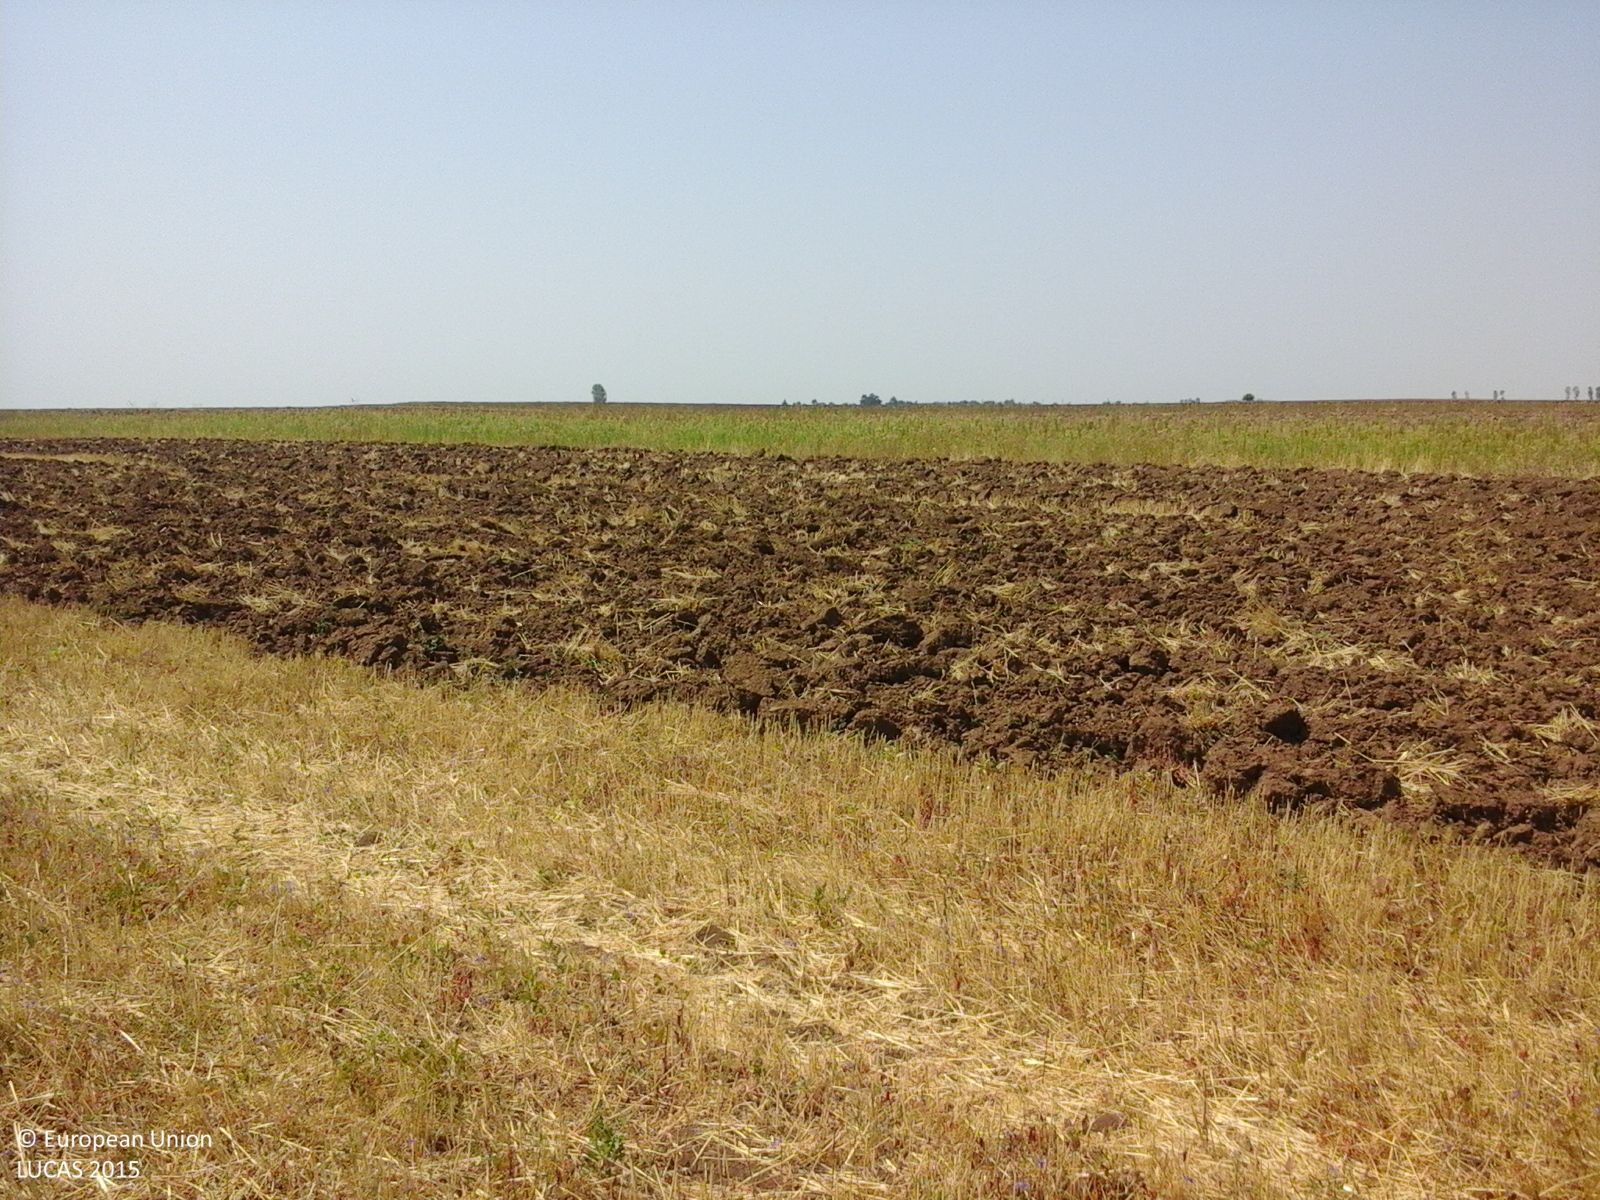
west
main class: Cropland
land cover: Sunflower
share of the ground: > 75 %
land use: Agriculture (excluding fallow land and kitchen gardens)
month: August
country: RO
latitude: 44.2377
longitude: 23.3078
